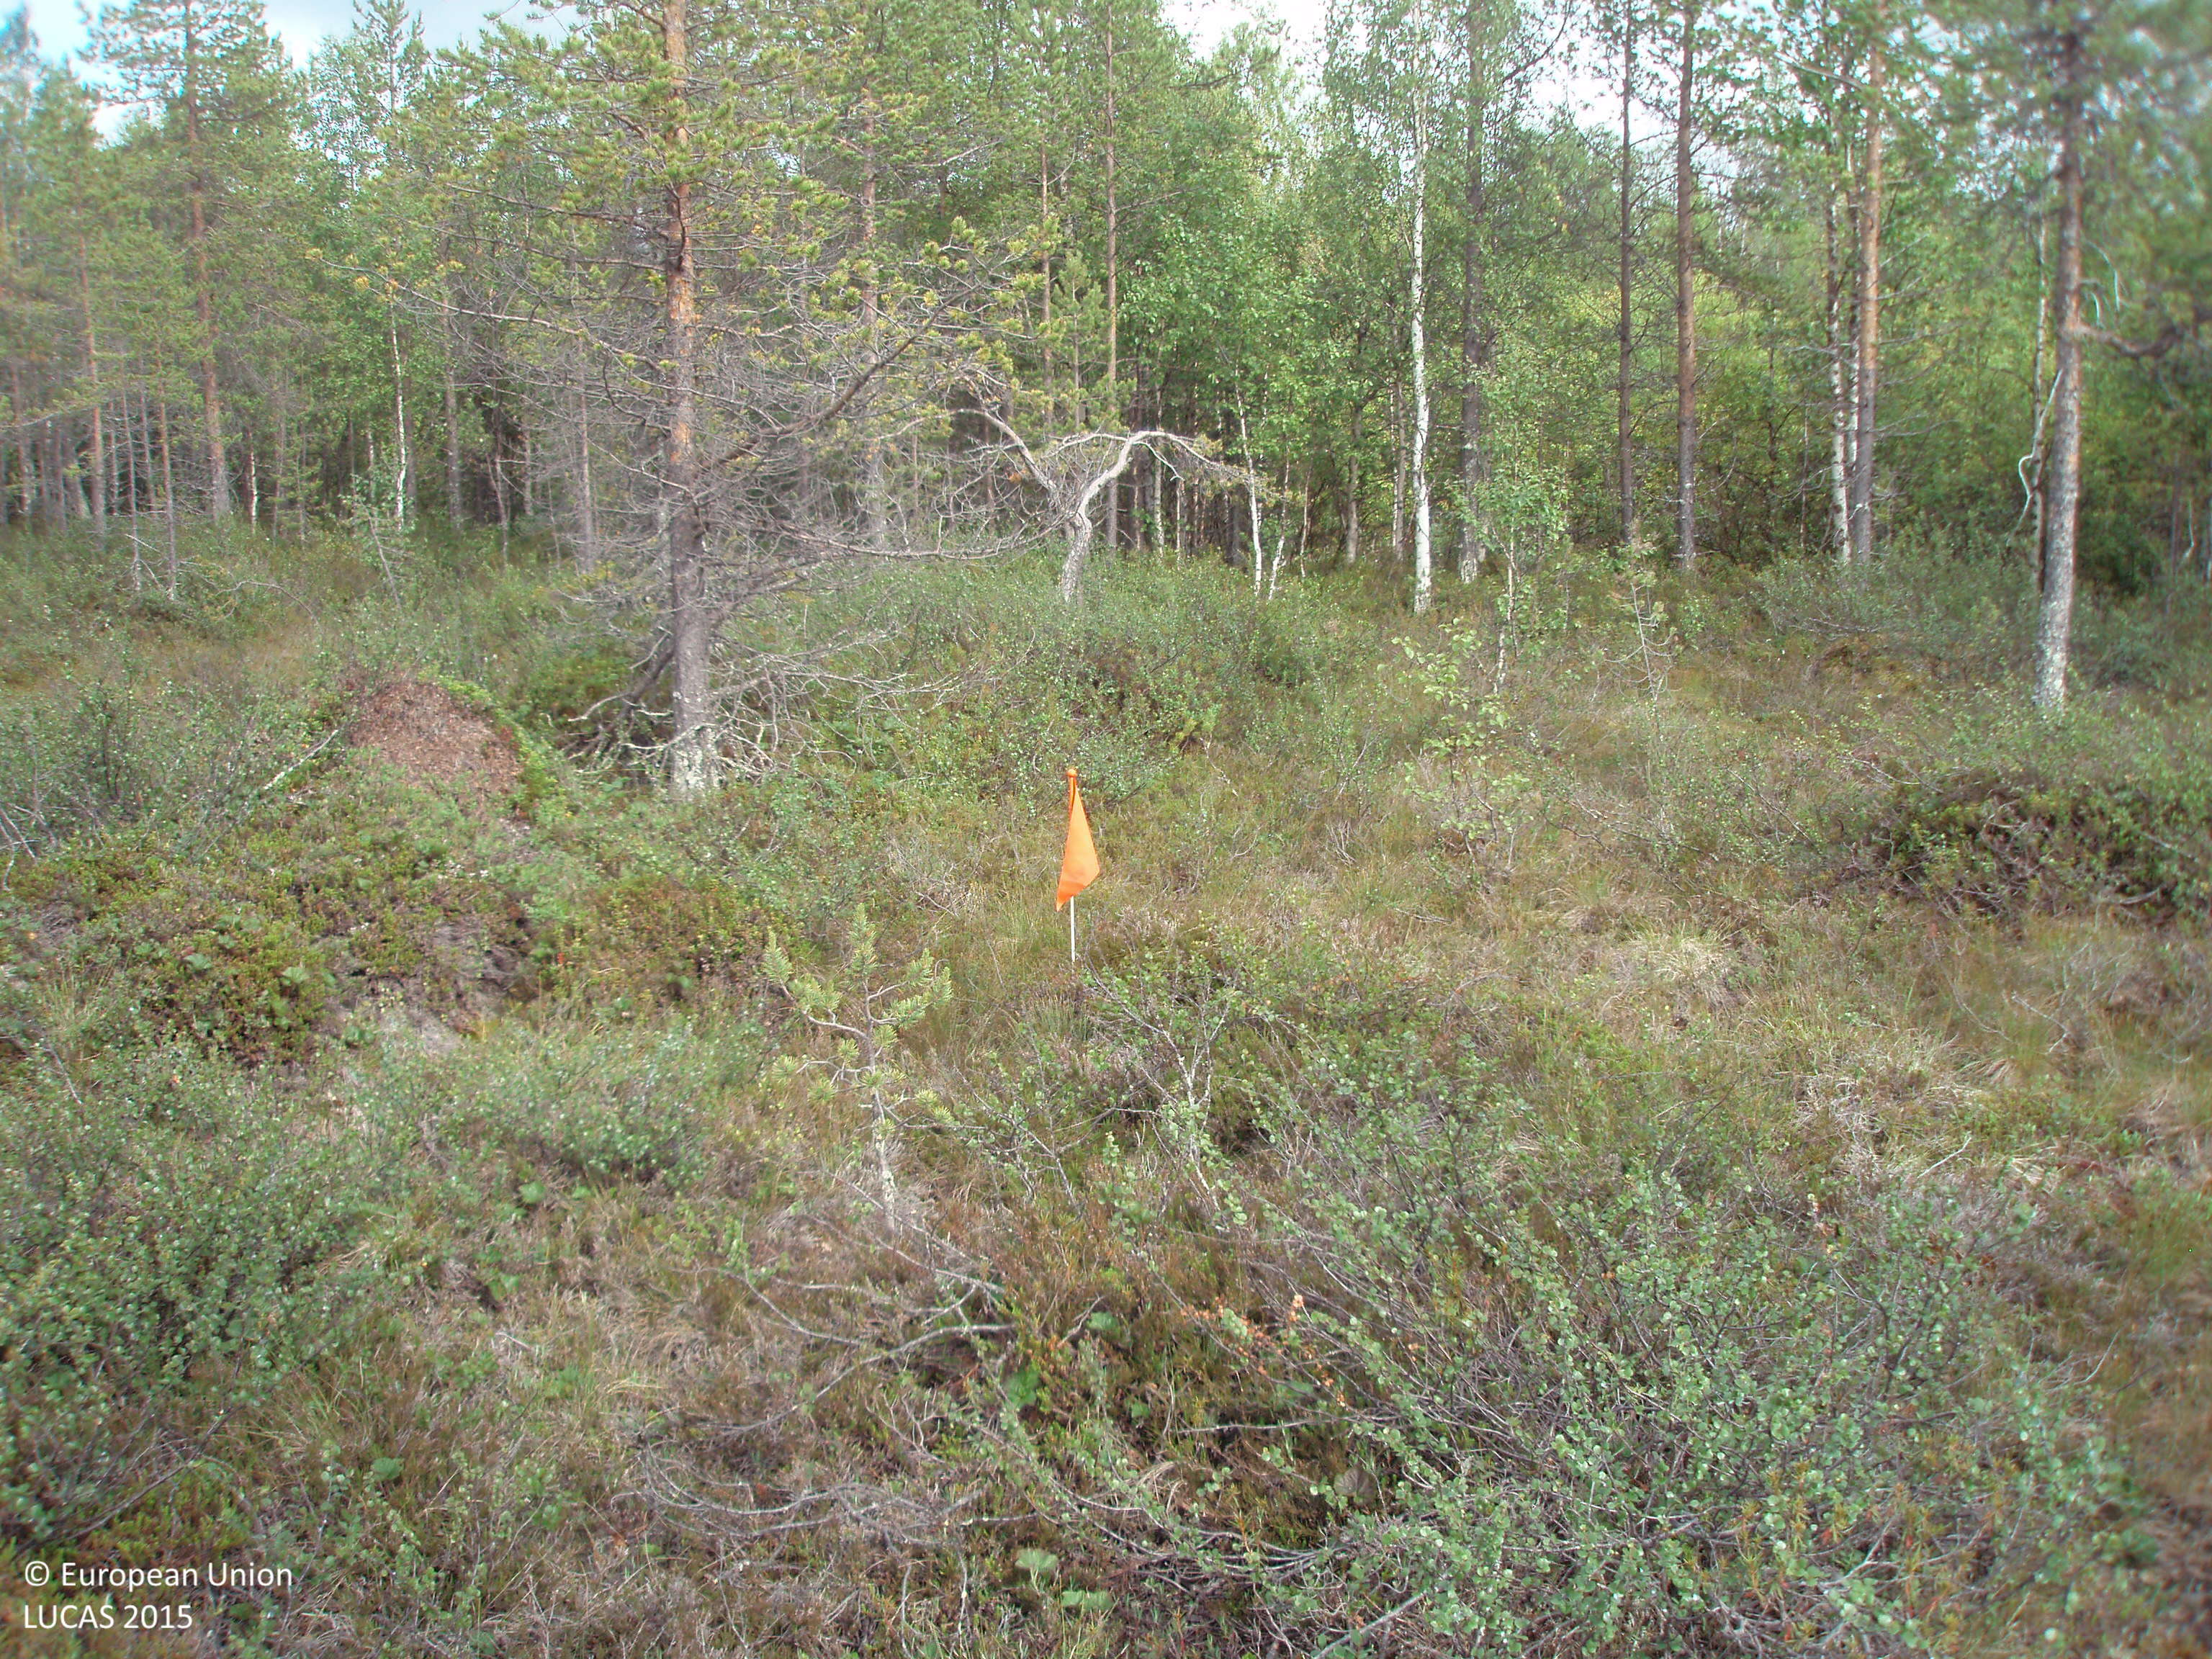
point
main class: Woodland
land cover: Pine dominated coniferous woodland
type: boreal forest
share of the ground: 10 - 25 %
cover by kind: shrubs 60 %, coniferous forest trees 20 %, lichens and mosses 15 %, herbaceous plants 5 %
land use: Semi-natural and natural areas not in use
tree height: > 5 m
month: July
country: FI
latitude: 66.8802
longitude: 28.5591
